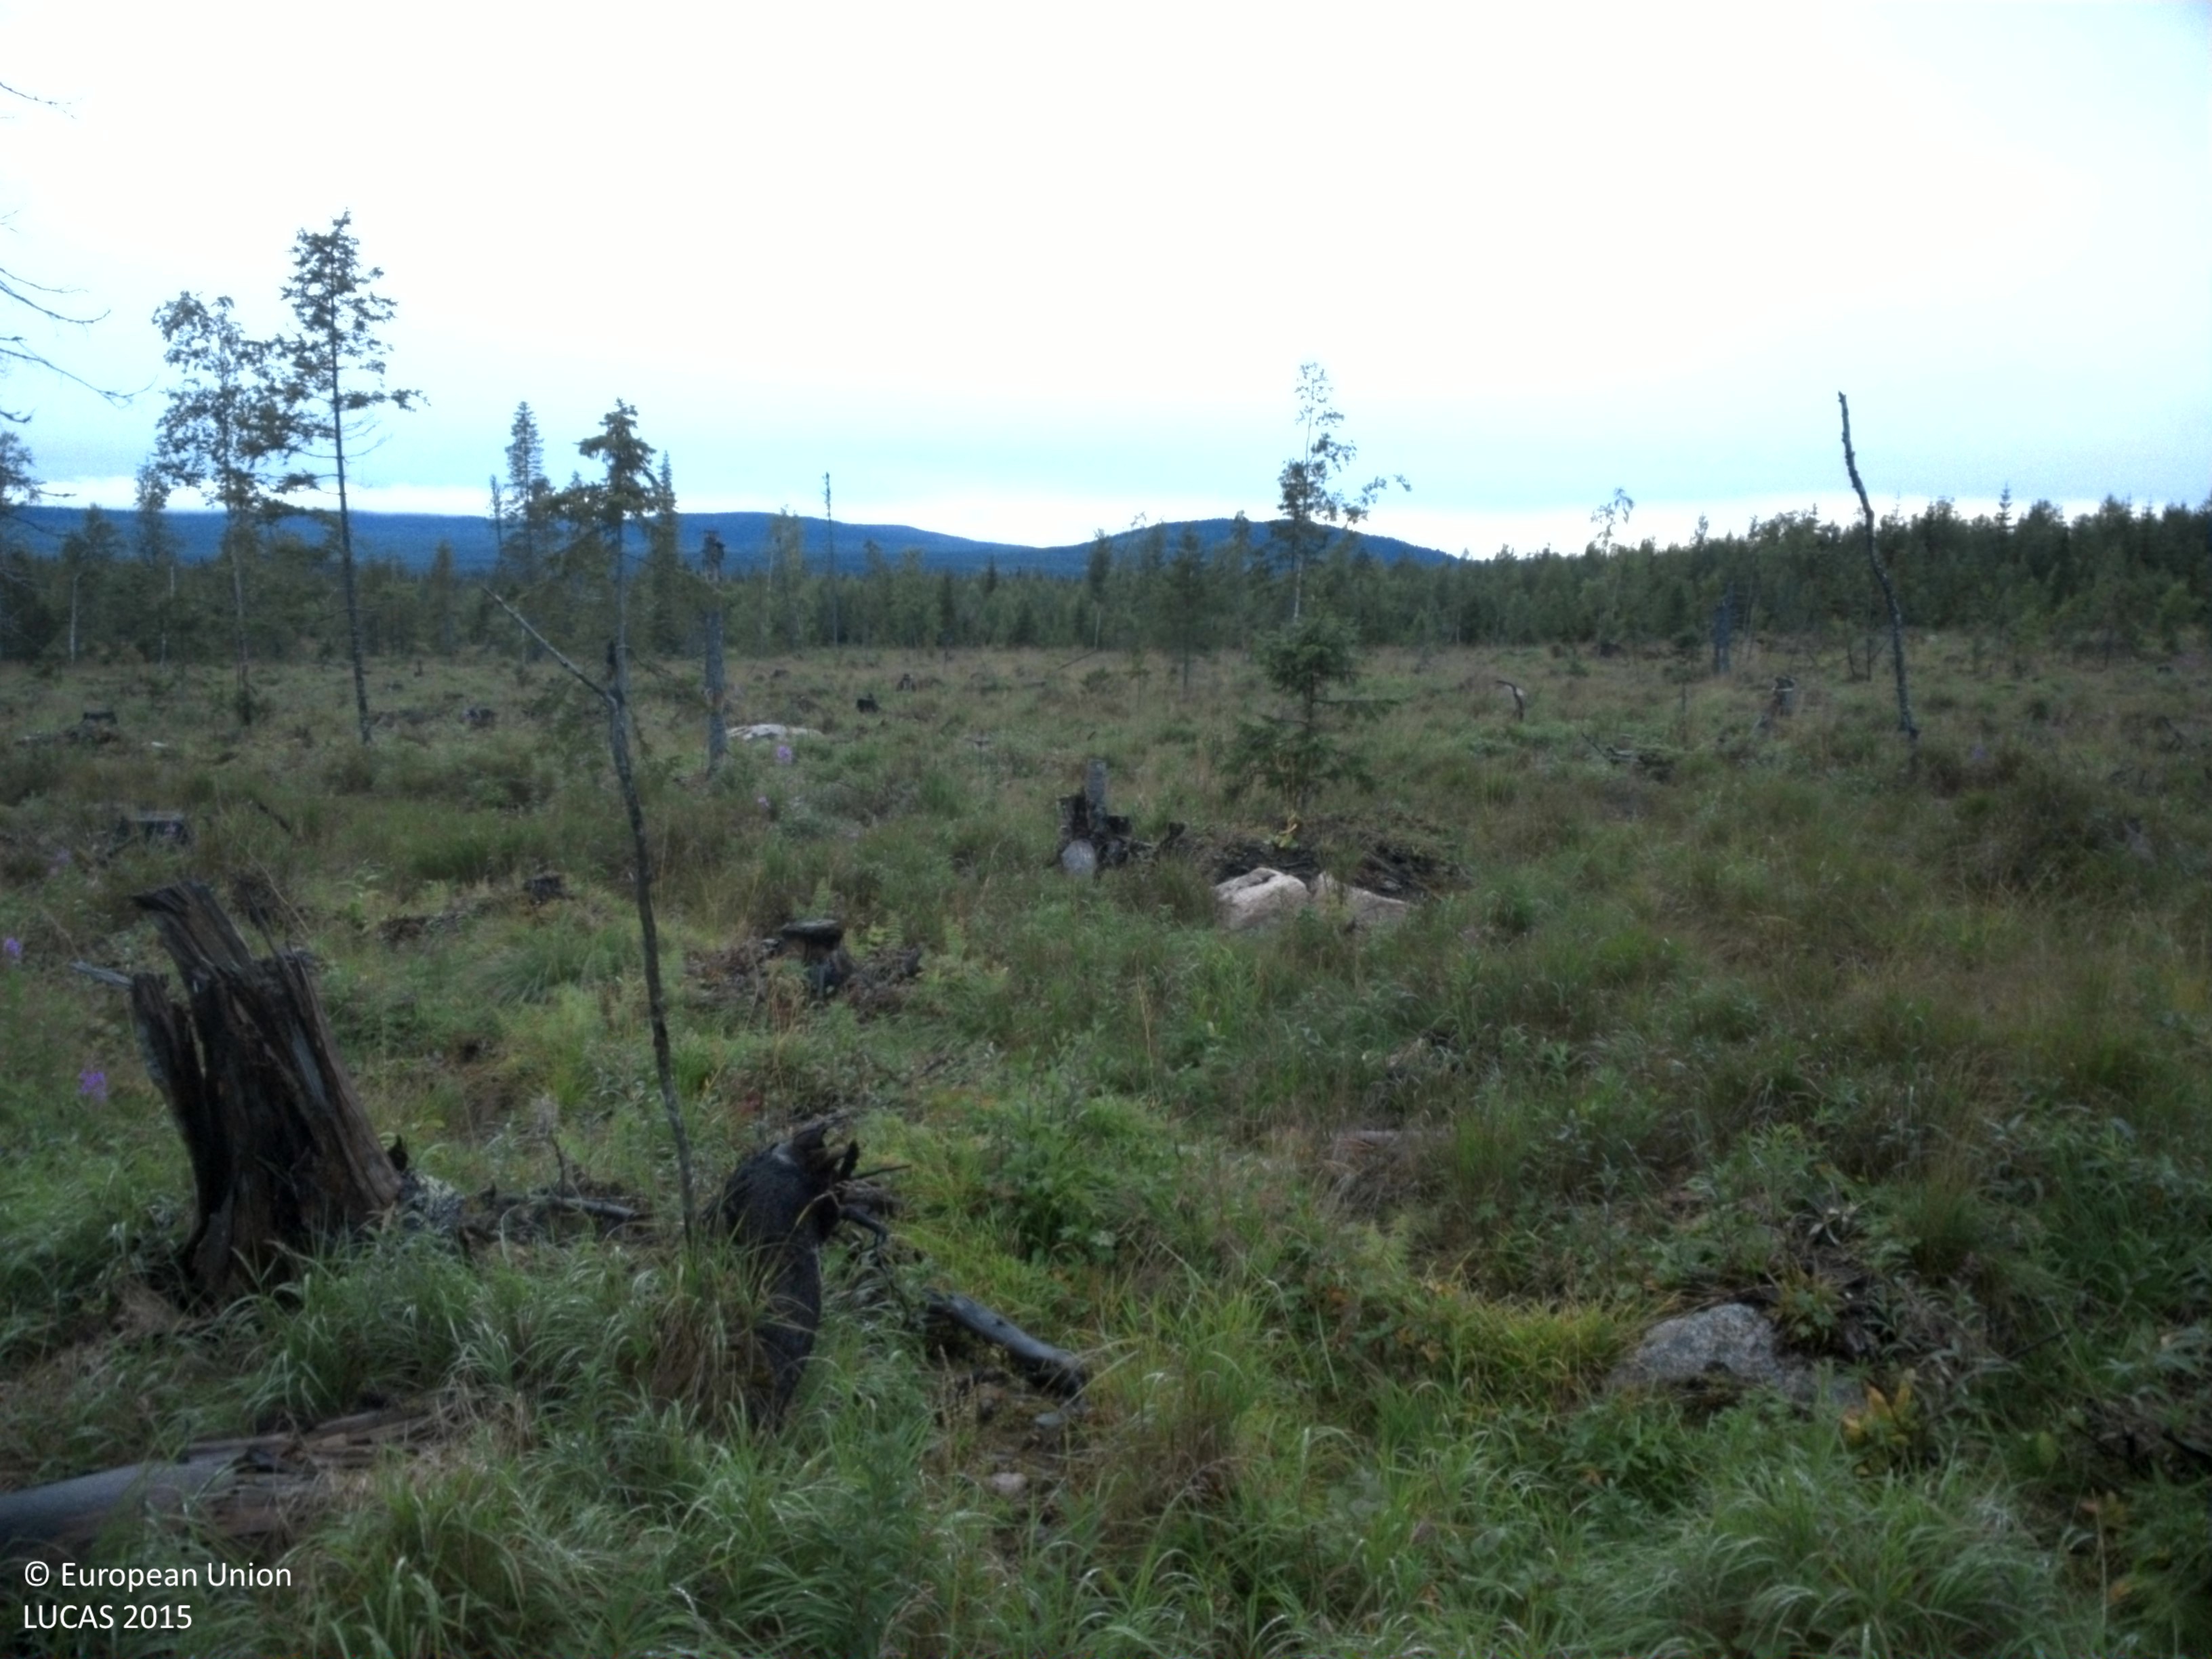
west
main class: Grassland
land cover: Grassland with sparse tree/shrub cover
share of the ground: > 75 %
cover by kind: herbaceous plants 90 %, coniferous forest trees 5 %, shrubs 5 %
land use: Forestry
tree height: < 5 m
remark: Clear cut
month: August
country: SE
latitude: 64.8483
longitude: 16.8606
